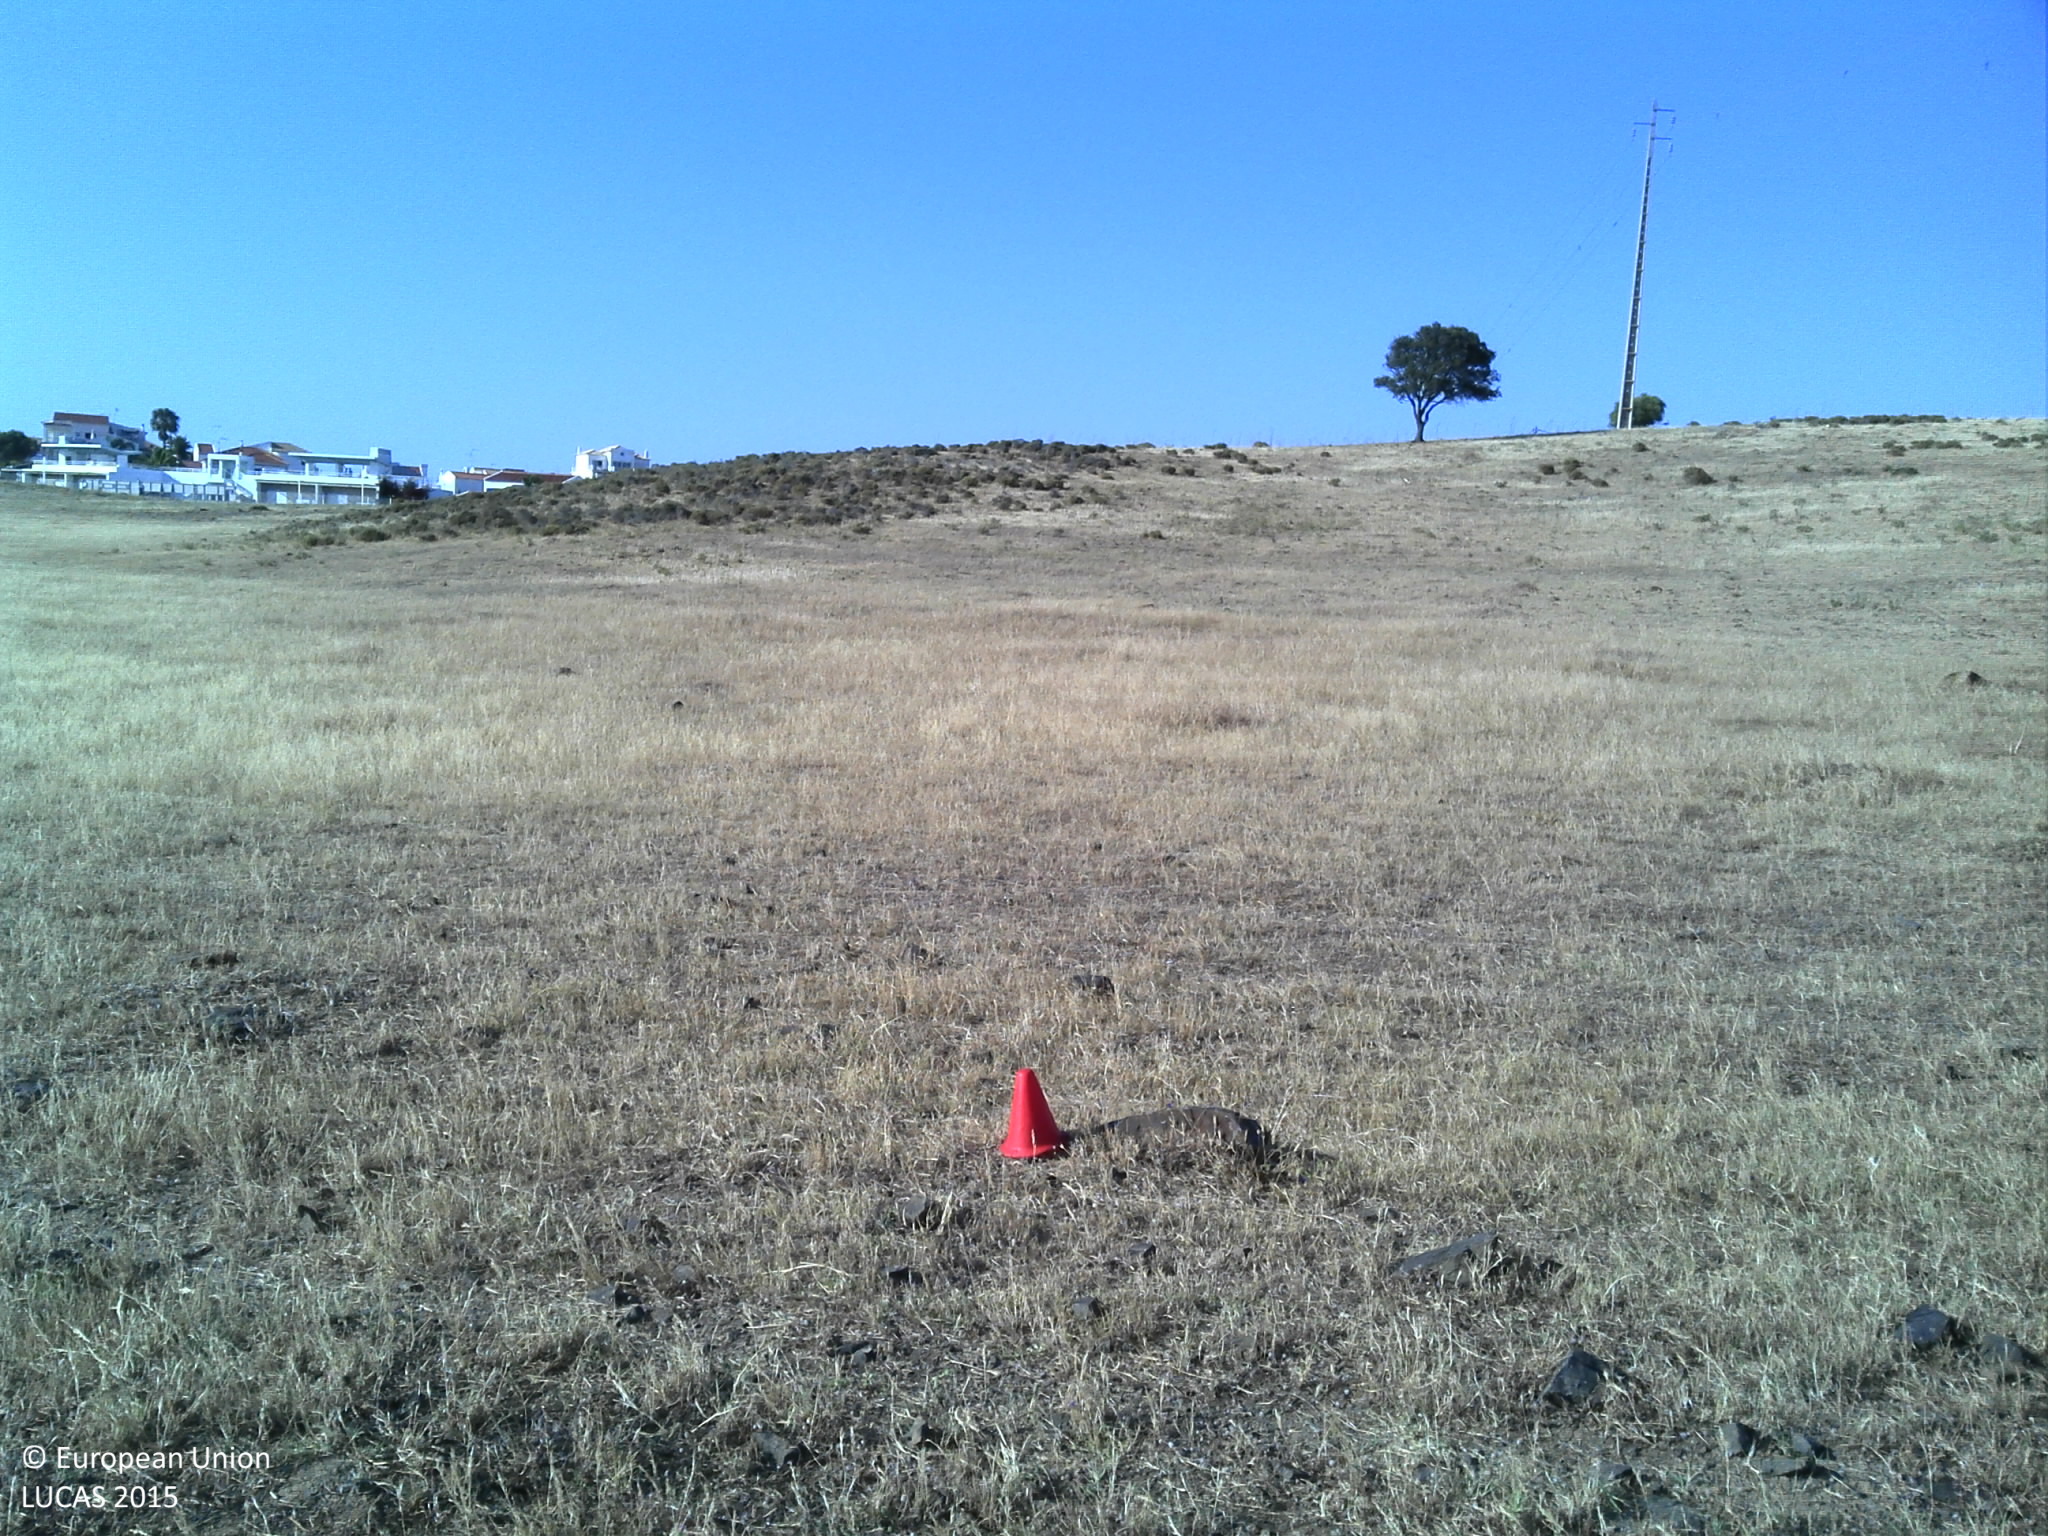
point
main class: Grassland
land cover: Grassland without tree/shrub cover
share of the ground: > 75 %
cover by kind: herbaceous plants 100 %
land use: Agriculture (excluding fallow land and kitchen gardens)
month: May
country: PT
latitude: 37.2064
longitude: -7.4787
